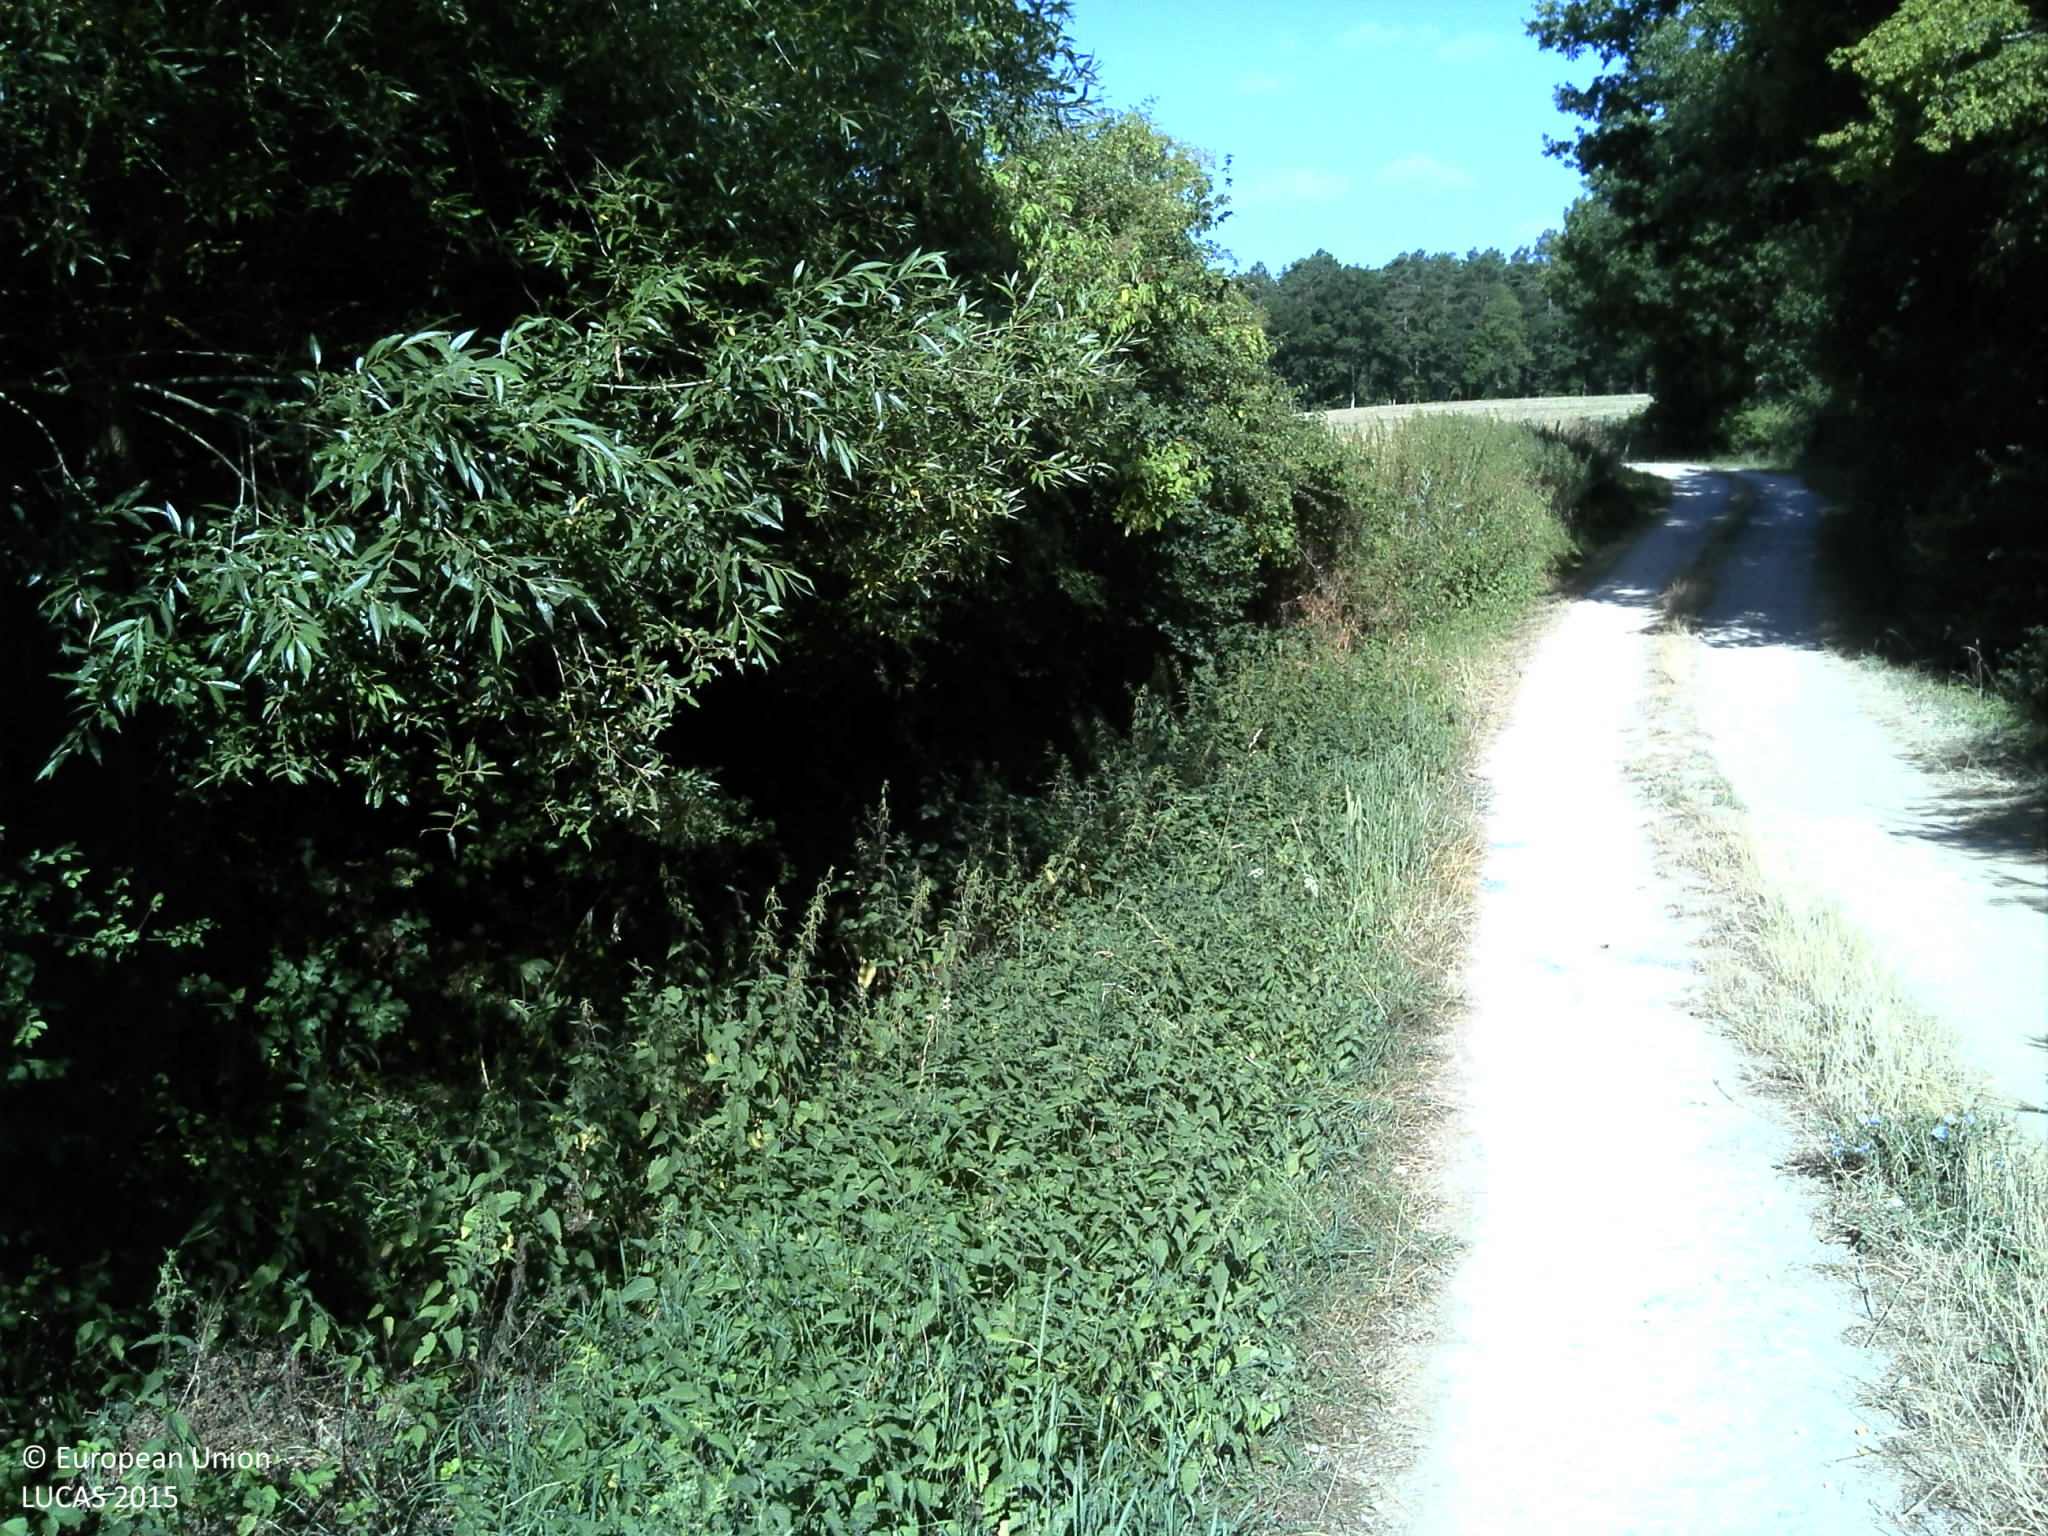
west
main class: Woodland
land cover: Broadleaved woodland
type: thermophilous deciduous forest
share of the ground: > 75 %
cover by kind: broadleaved forest trees 100 %
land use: Forestry
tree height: > 5 m
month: July
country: FR
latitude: 48.2421
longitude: 6.0280
